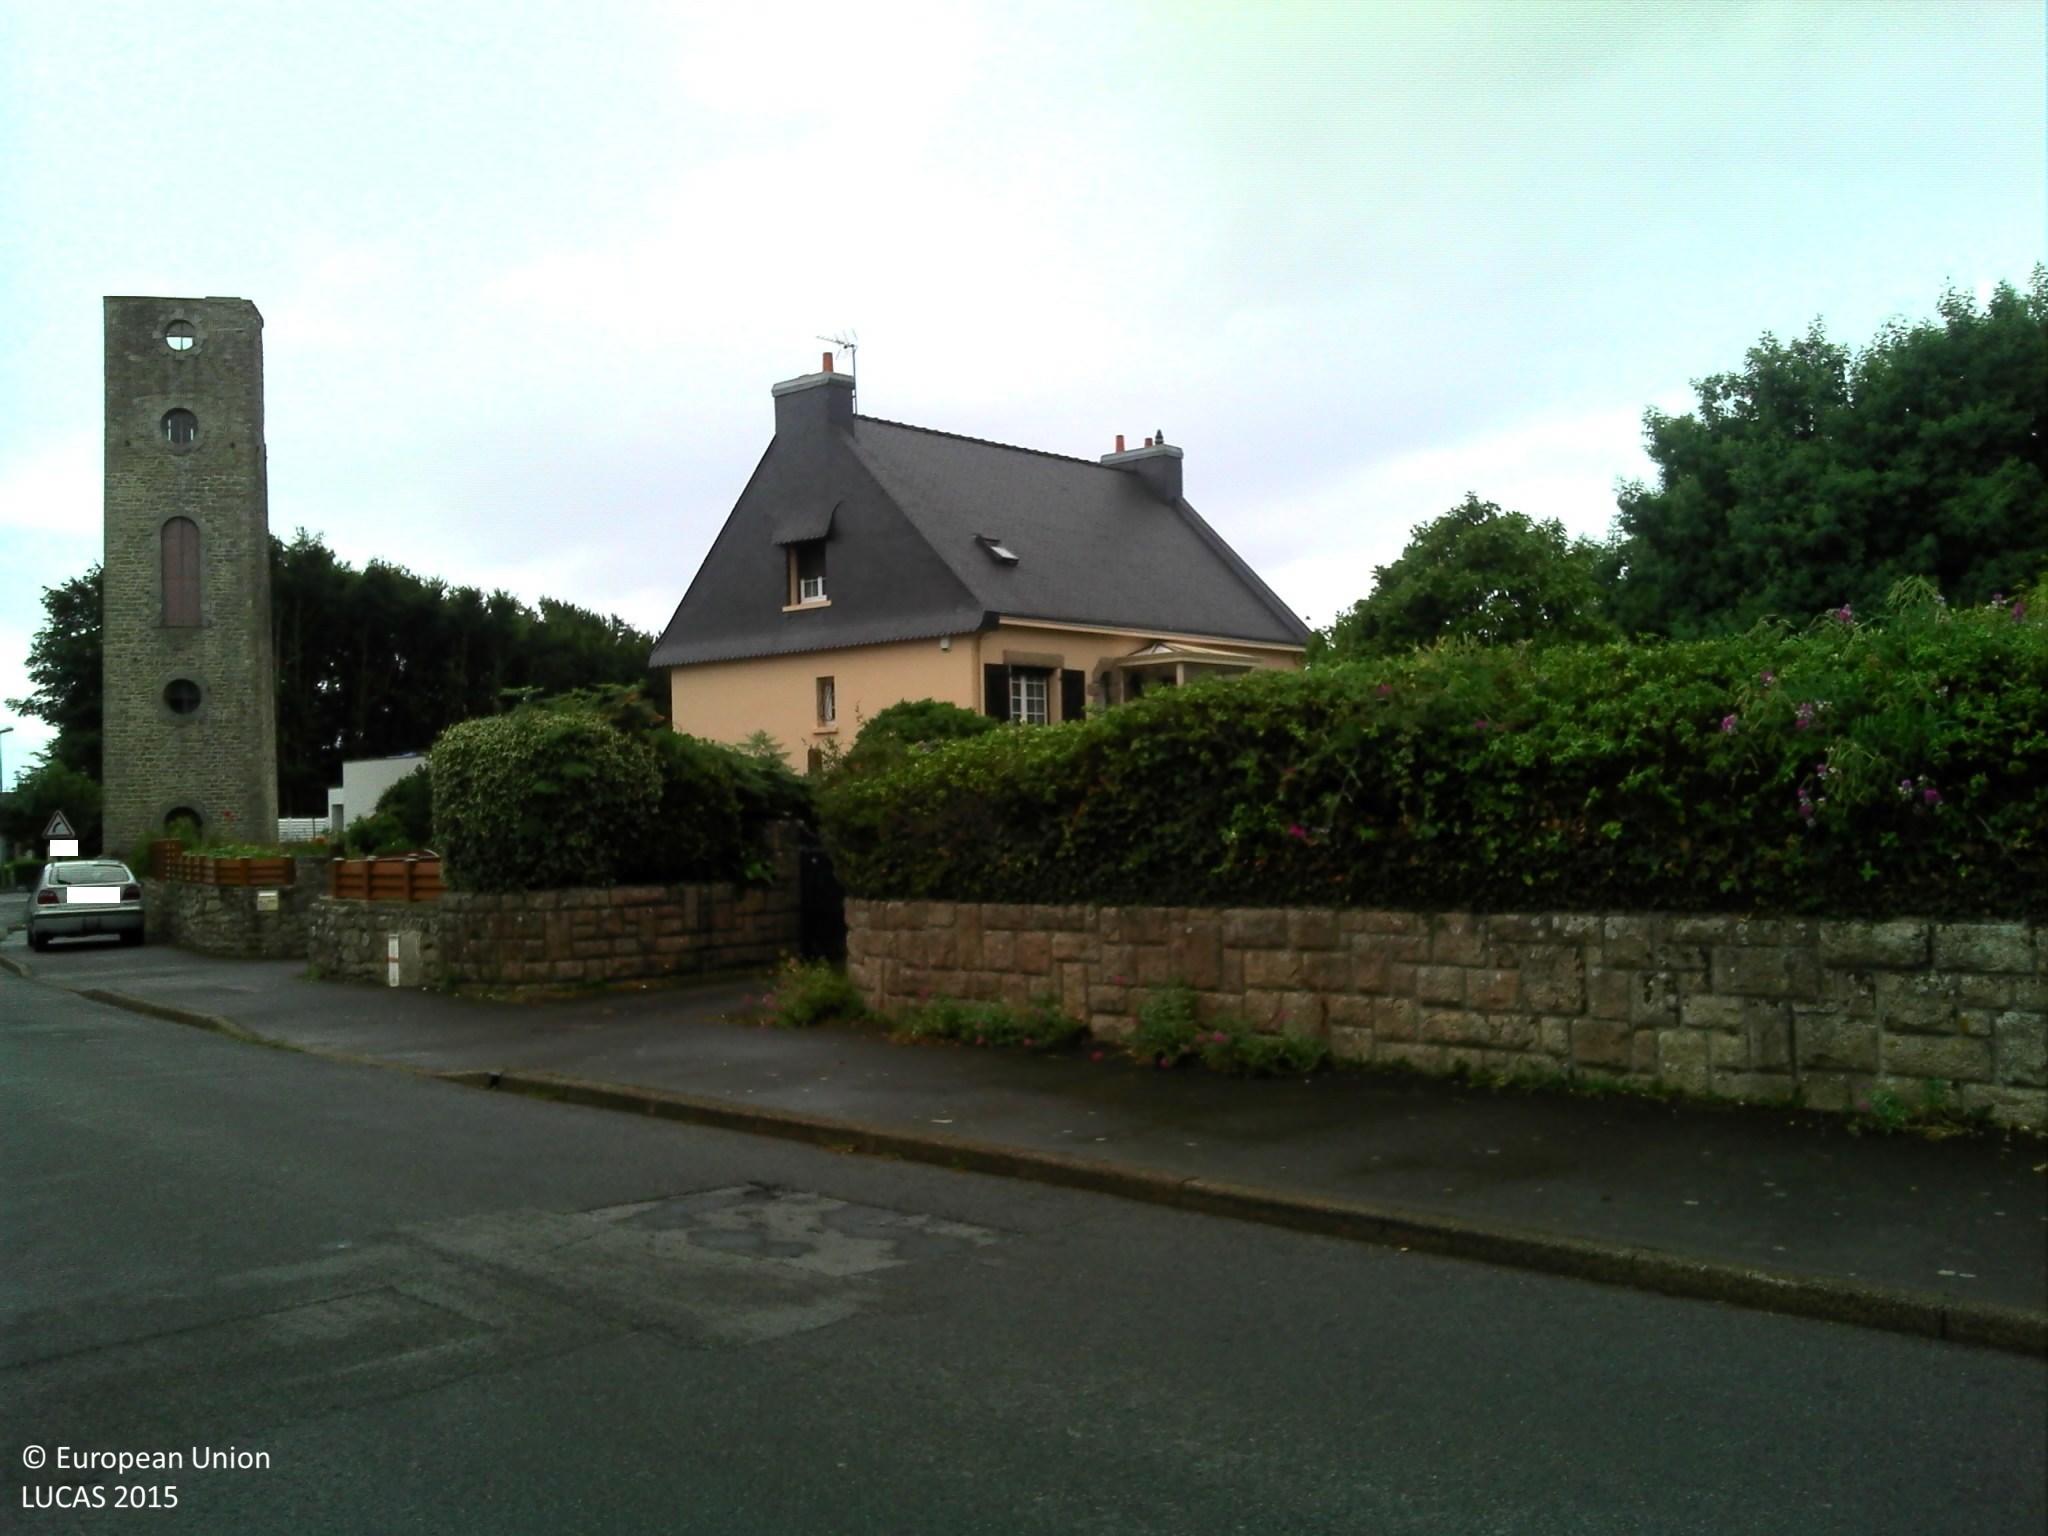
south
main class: Grassland
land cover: Grassland without tree/shrub cover
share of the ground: > 75 %
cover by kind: herbaceous plants 100 %
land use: Residential
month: July
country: FR
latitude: 47.7059
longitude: -3.4411
